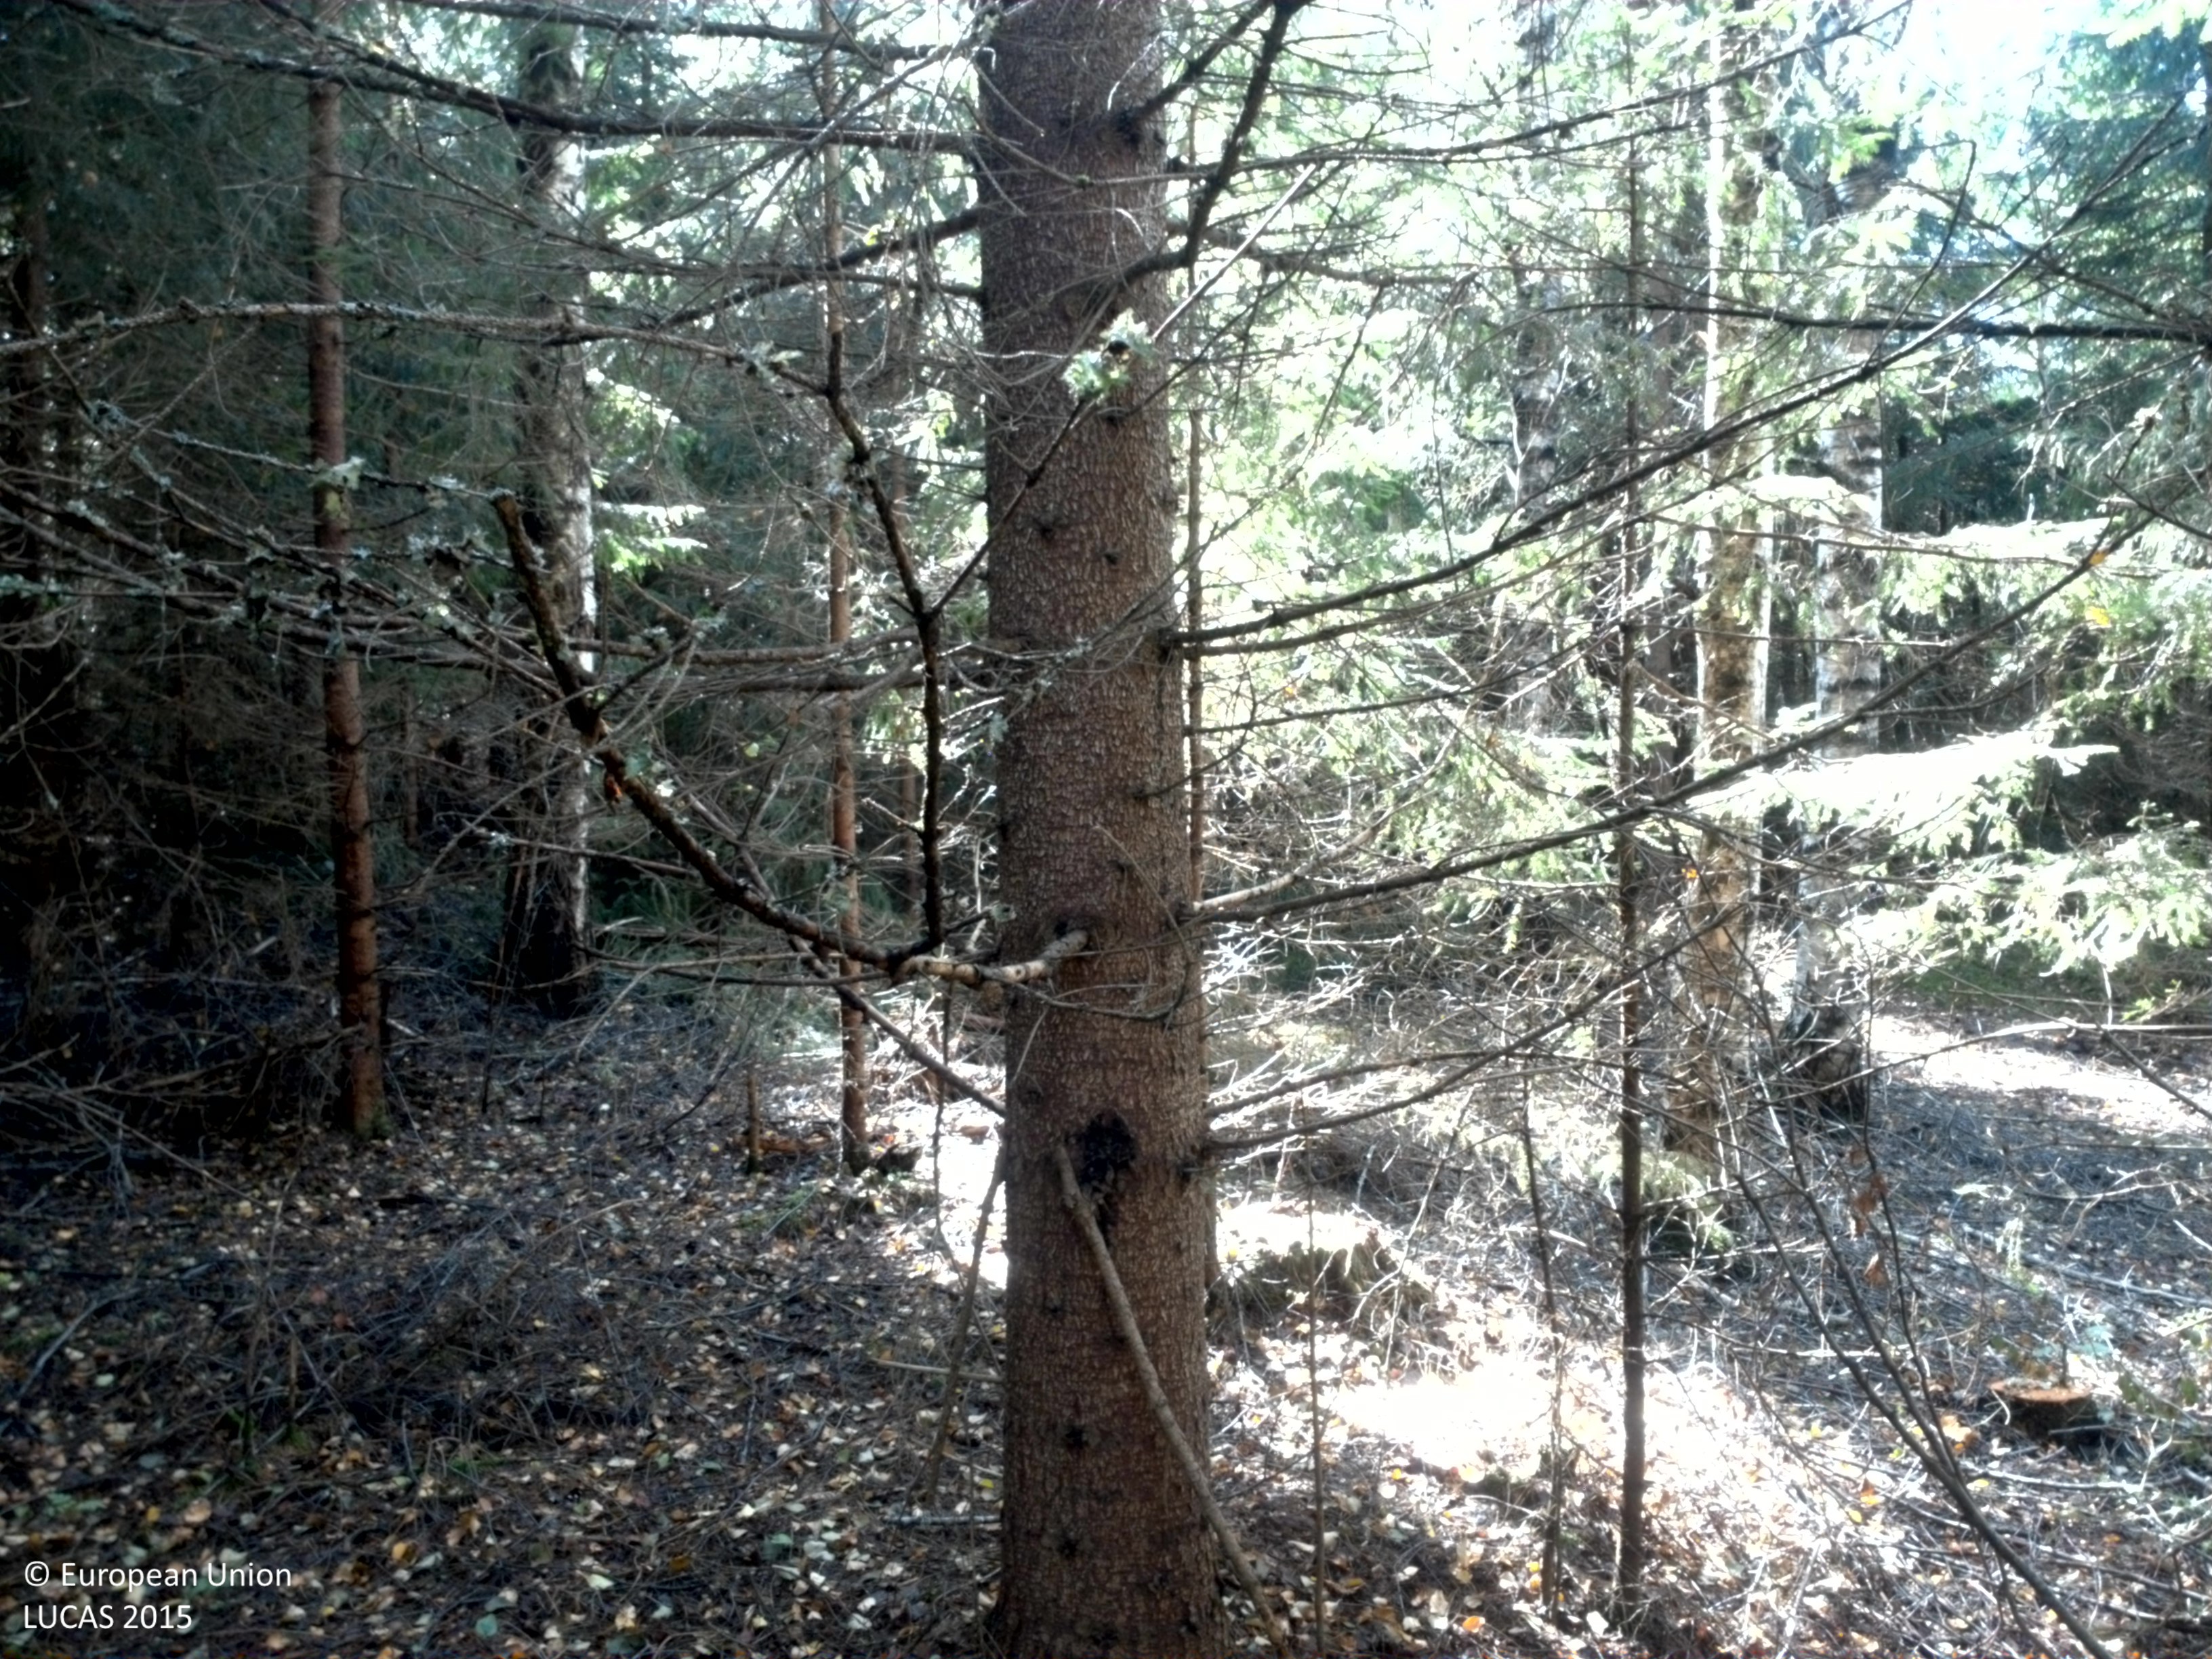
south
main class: Woodland
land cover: Spruce dominated coniferous woodland
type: boreal forest
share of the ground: 50 - 75 %
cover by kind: coniferous forest trees 65 %, lichens and mosses 25 %, shrubs 5 %, herbaceous plants 5 %
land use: Forestry
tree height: > 5 m
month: August
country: SE
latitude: 59.6699
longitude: 13.4536
